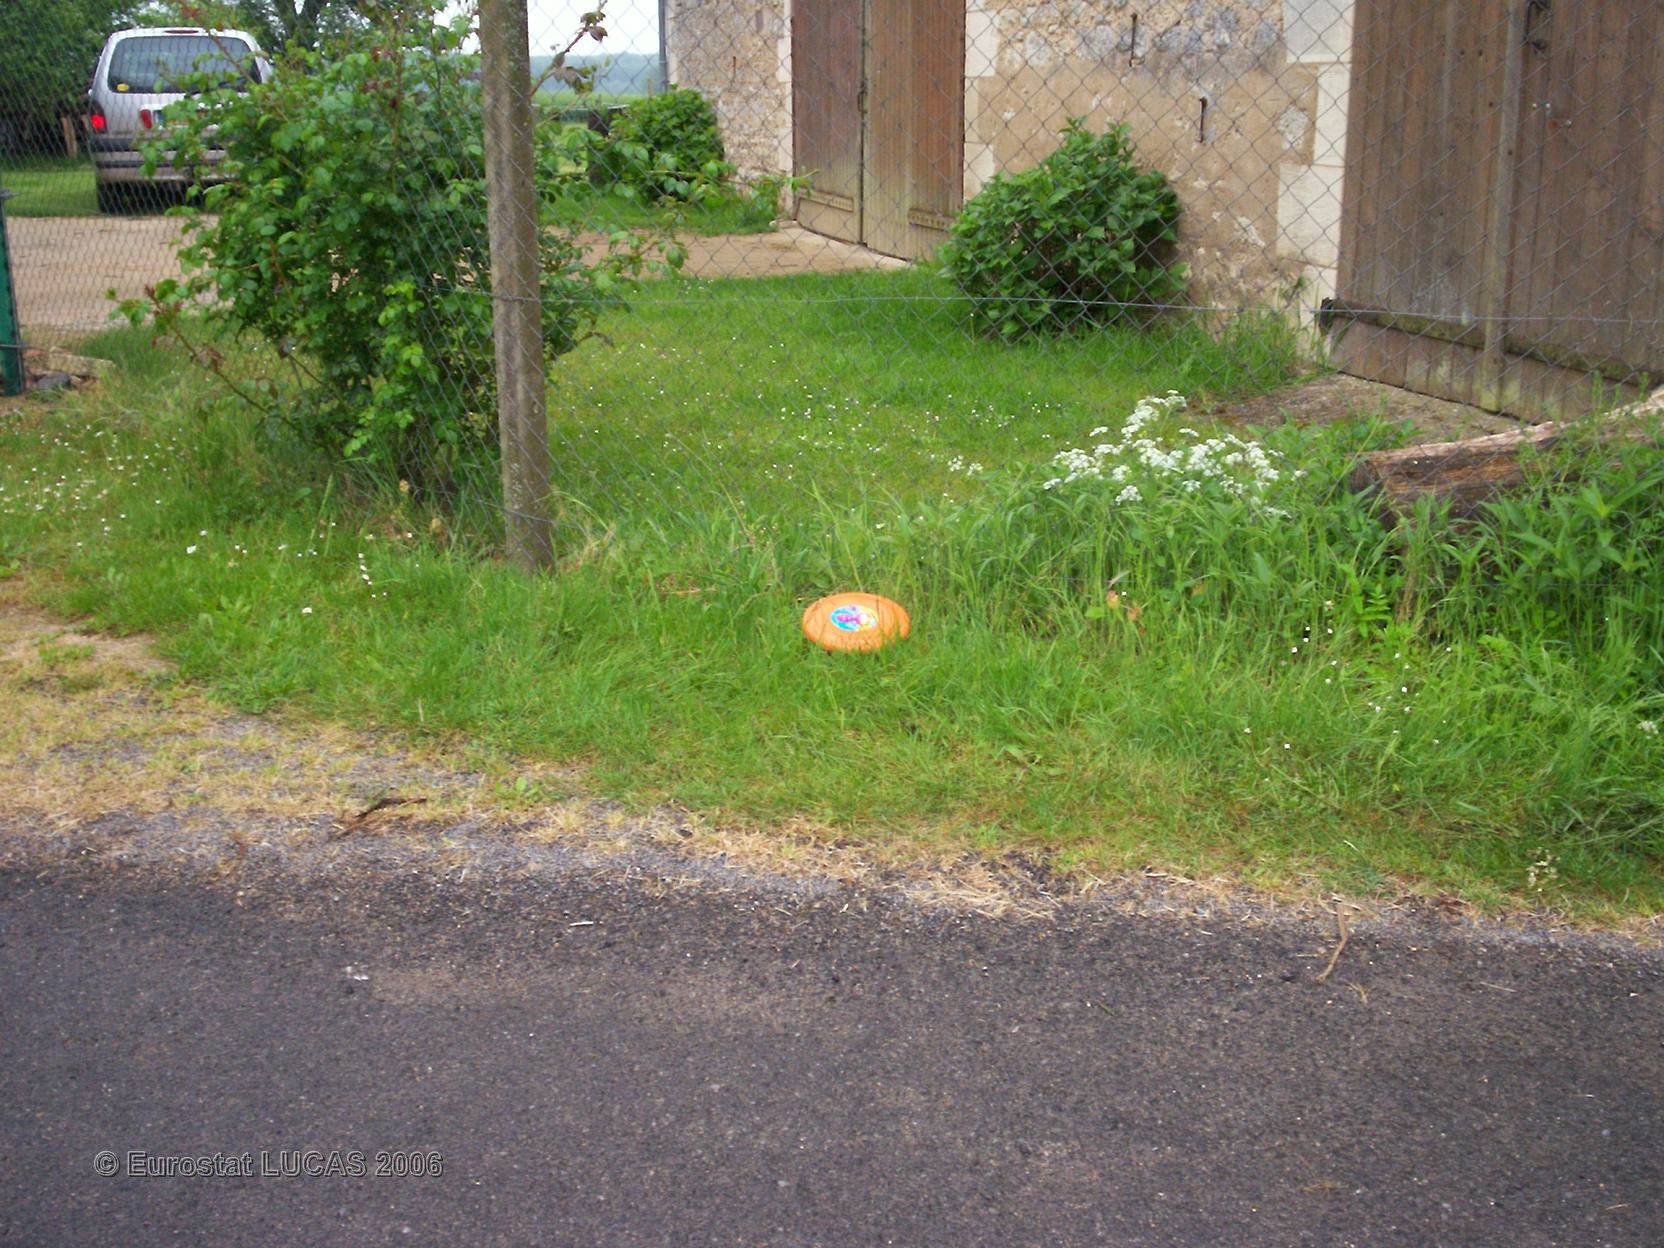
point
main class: Grassland
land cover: Grassland without tree/shrub cover
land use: Residential
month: May
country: FR
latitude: 46.5239
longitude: 0.4791
